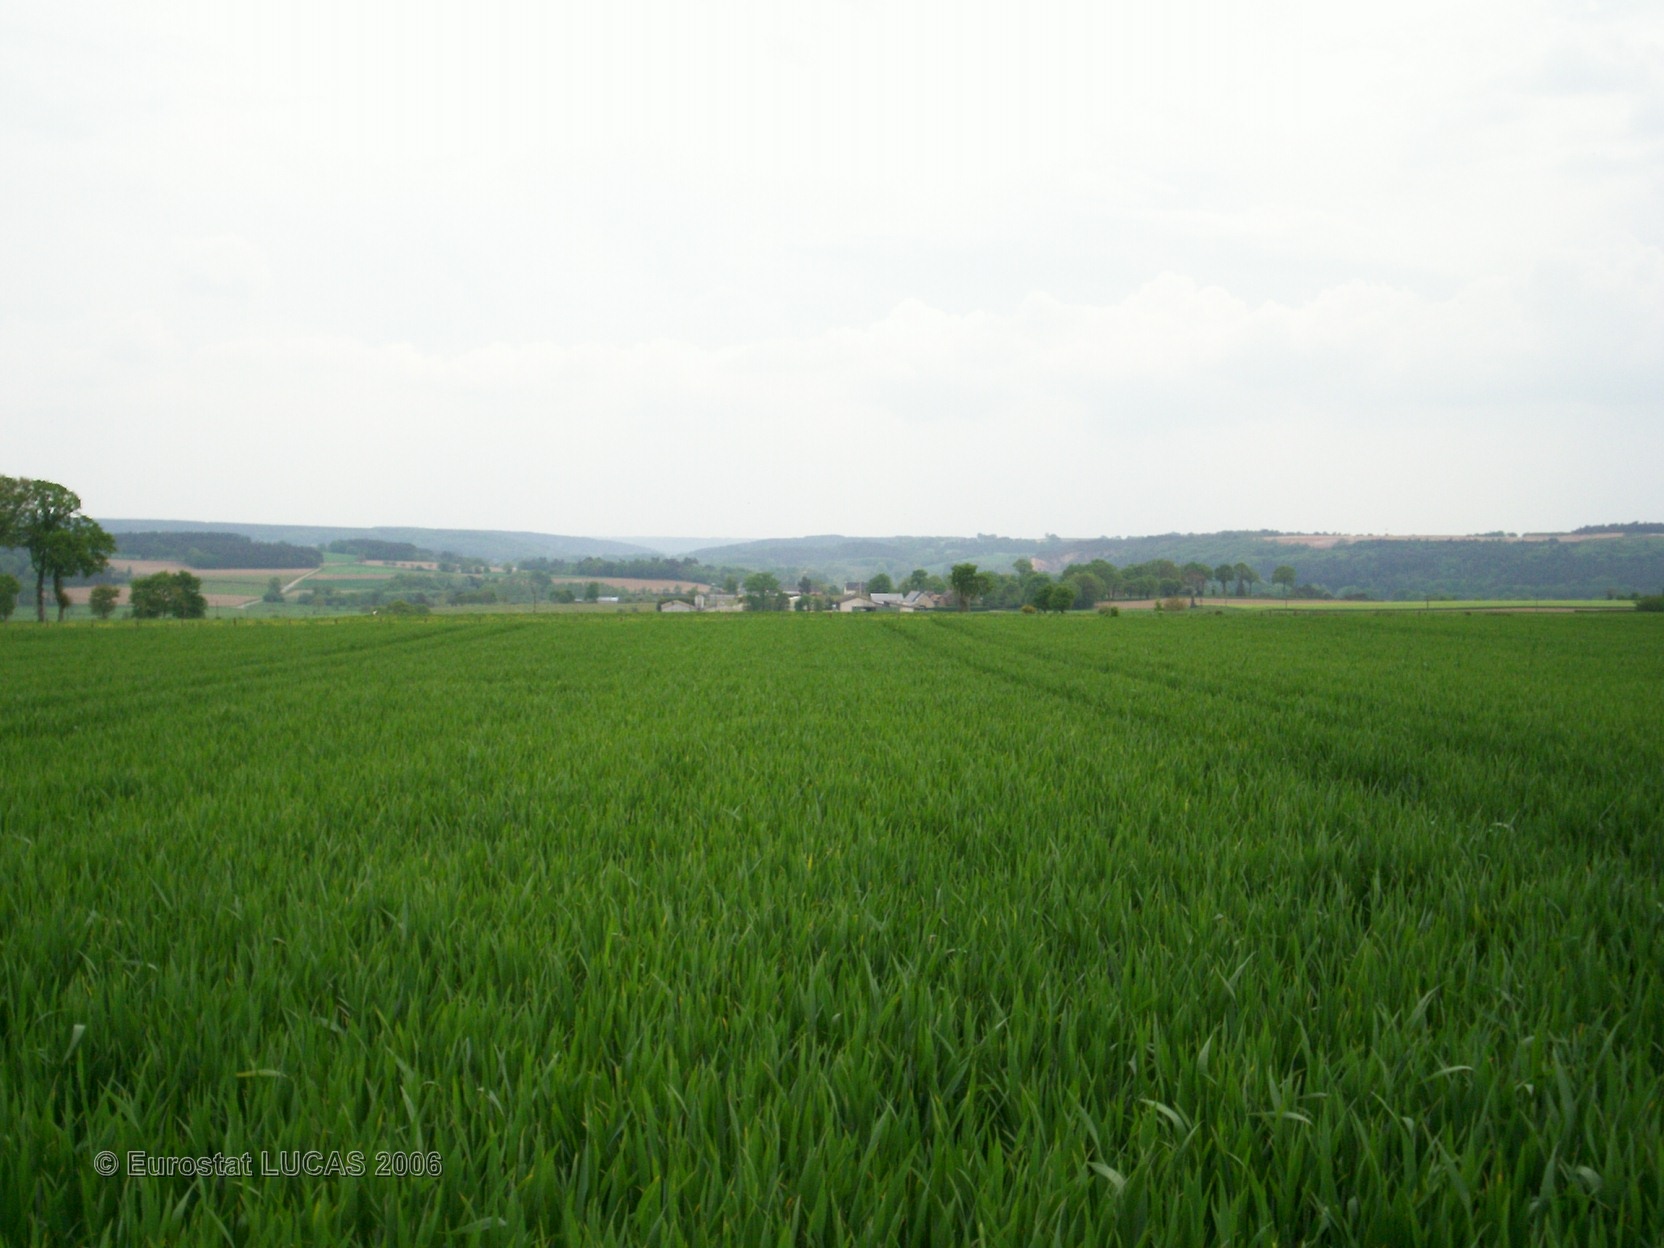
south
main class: Cropland
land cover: Common wheat
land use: Agriculture (excluding fallow land and kitchen gardens)
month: May
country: FR
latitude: 47.8194
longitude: -2.3304
